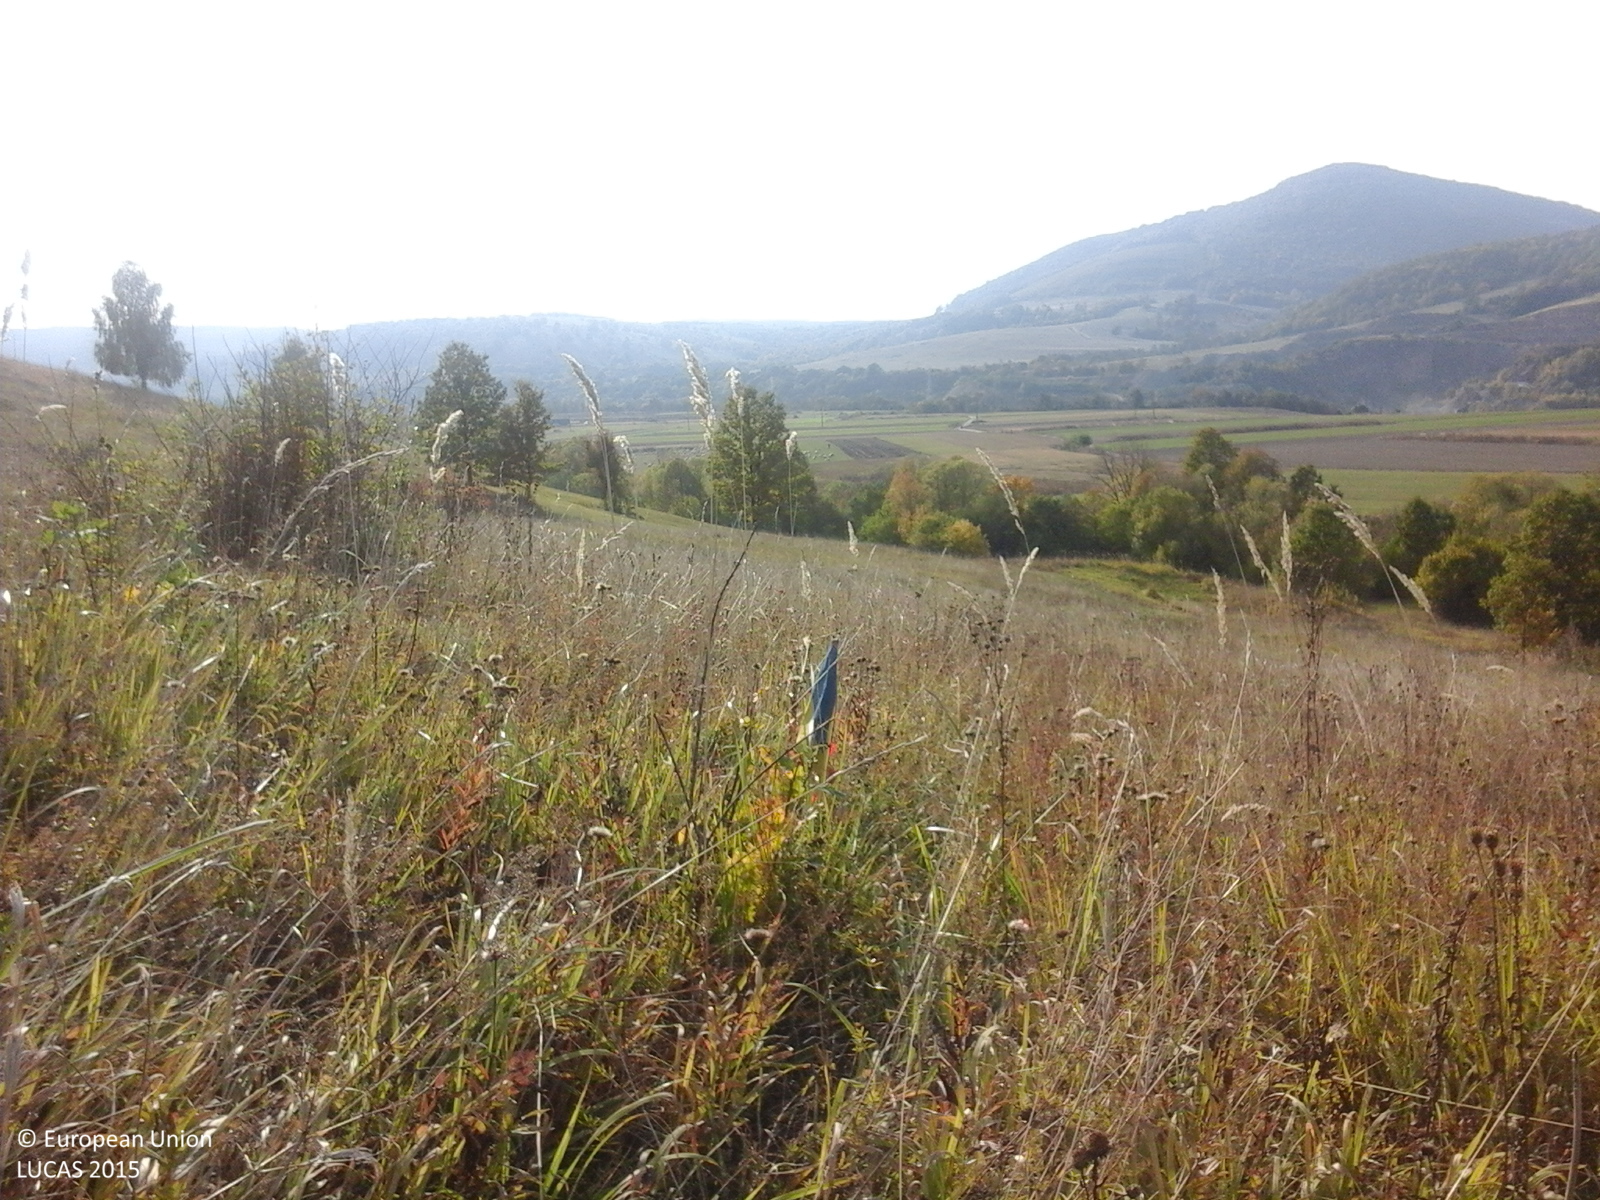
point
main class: Grassland
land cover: Grassland with sparse tree/shrub cover
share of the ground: > 75 %
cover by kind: herbaceous plants 95 %, broadleaved forest trees 5 %
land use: Agriculture (excluding fallow land and kitchen gardens)
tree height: > 5 m
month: October
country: RO
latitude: 46.0769
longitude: 25.8502
